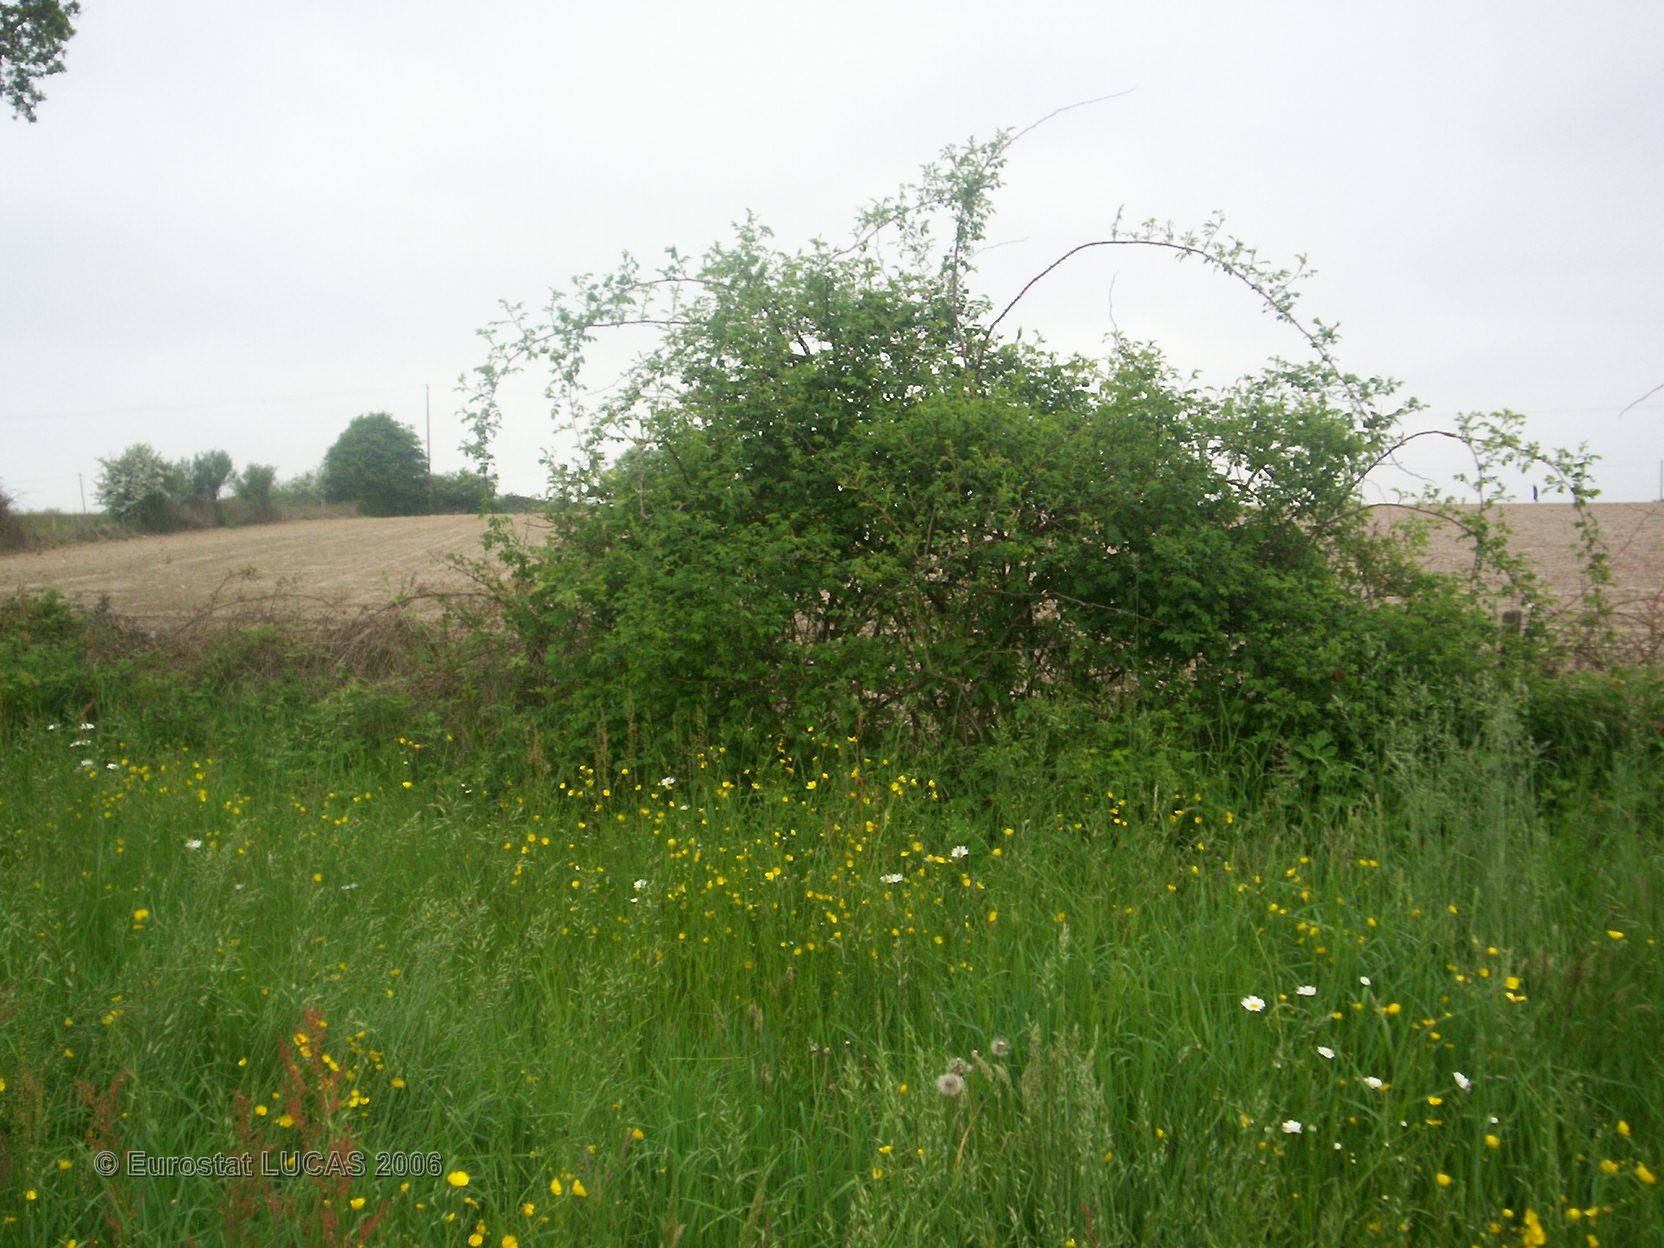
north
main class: Grassland
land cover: Grassland without tree/shrub cover
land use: Agriculture (excluding fallow land and kitchen gardens)
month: May
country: FR
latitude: 47.8264
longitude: 0.4527
